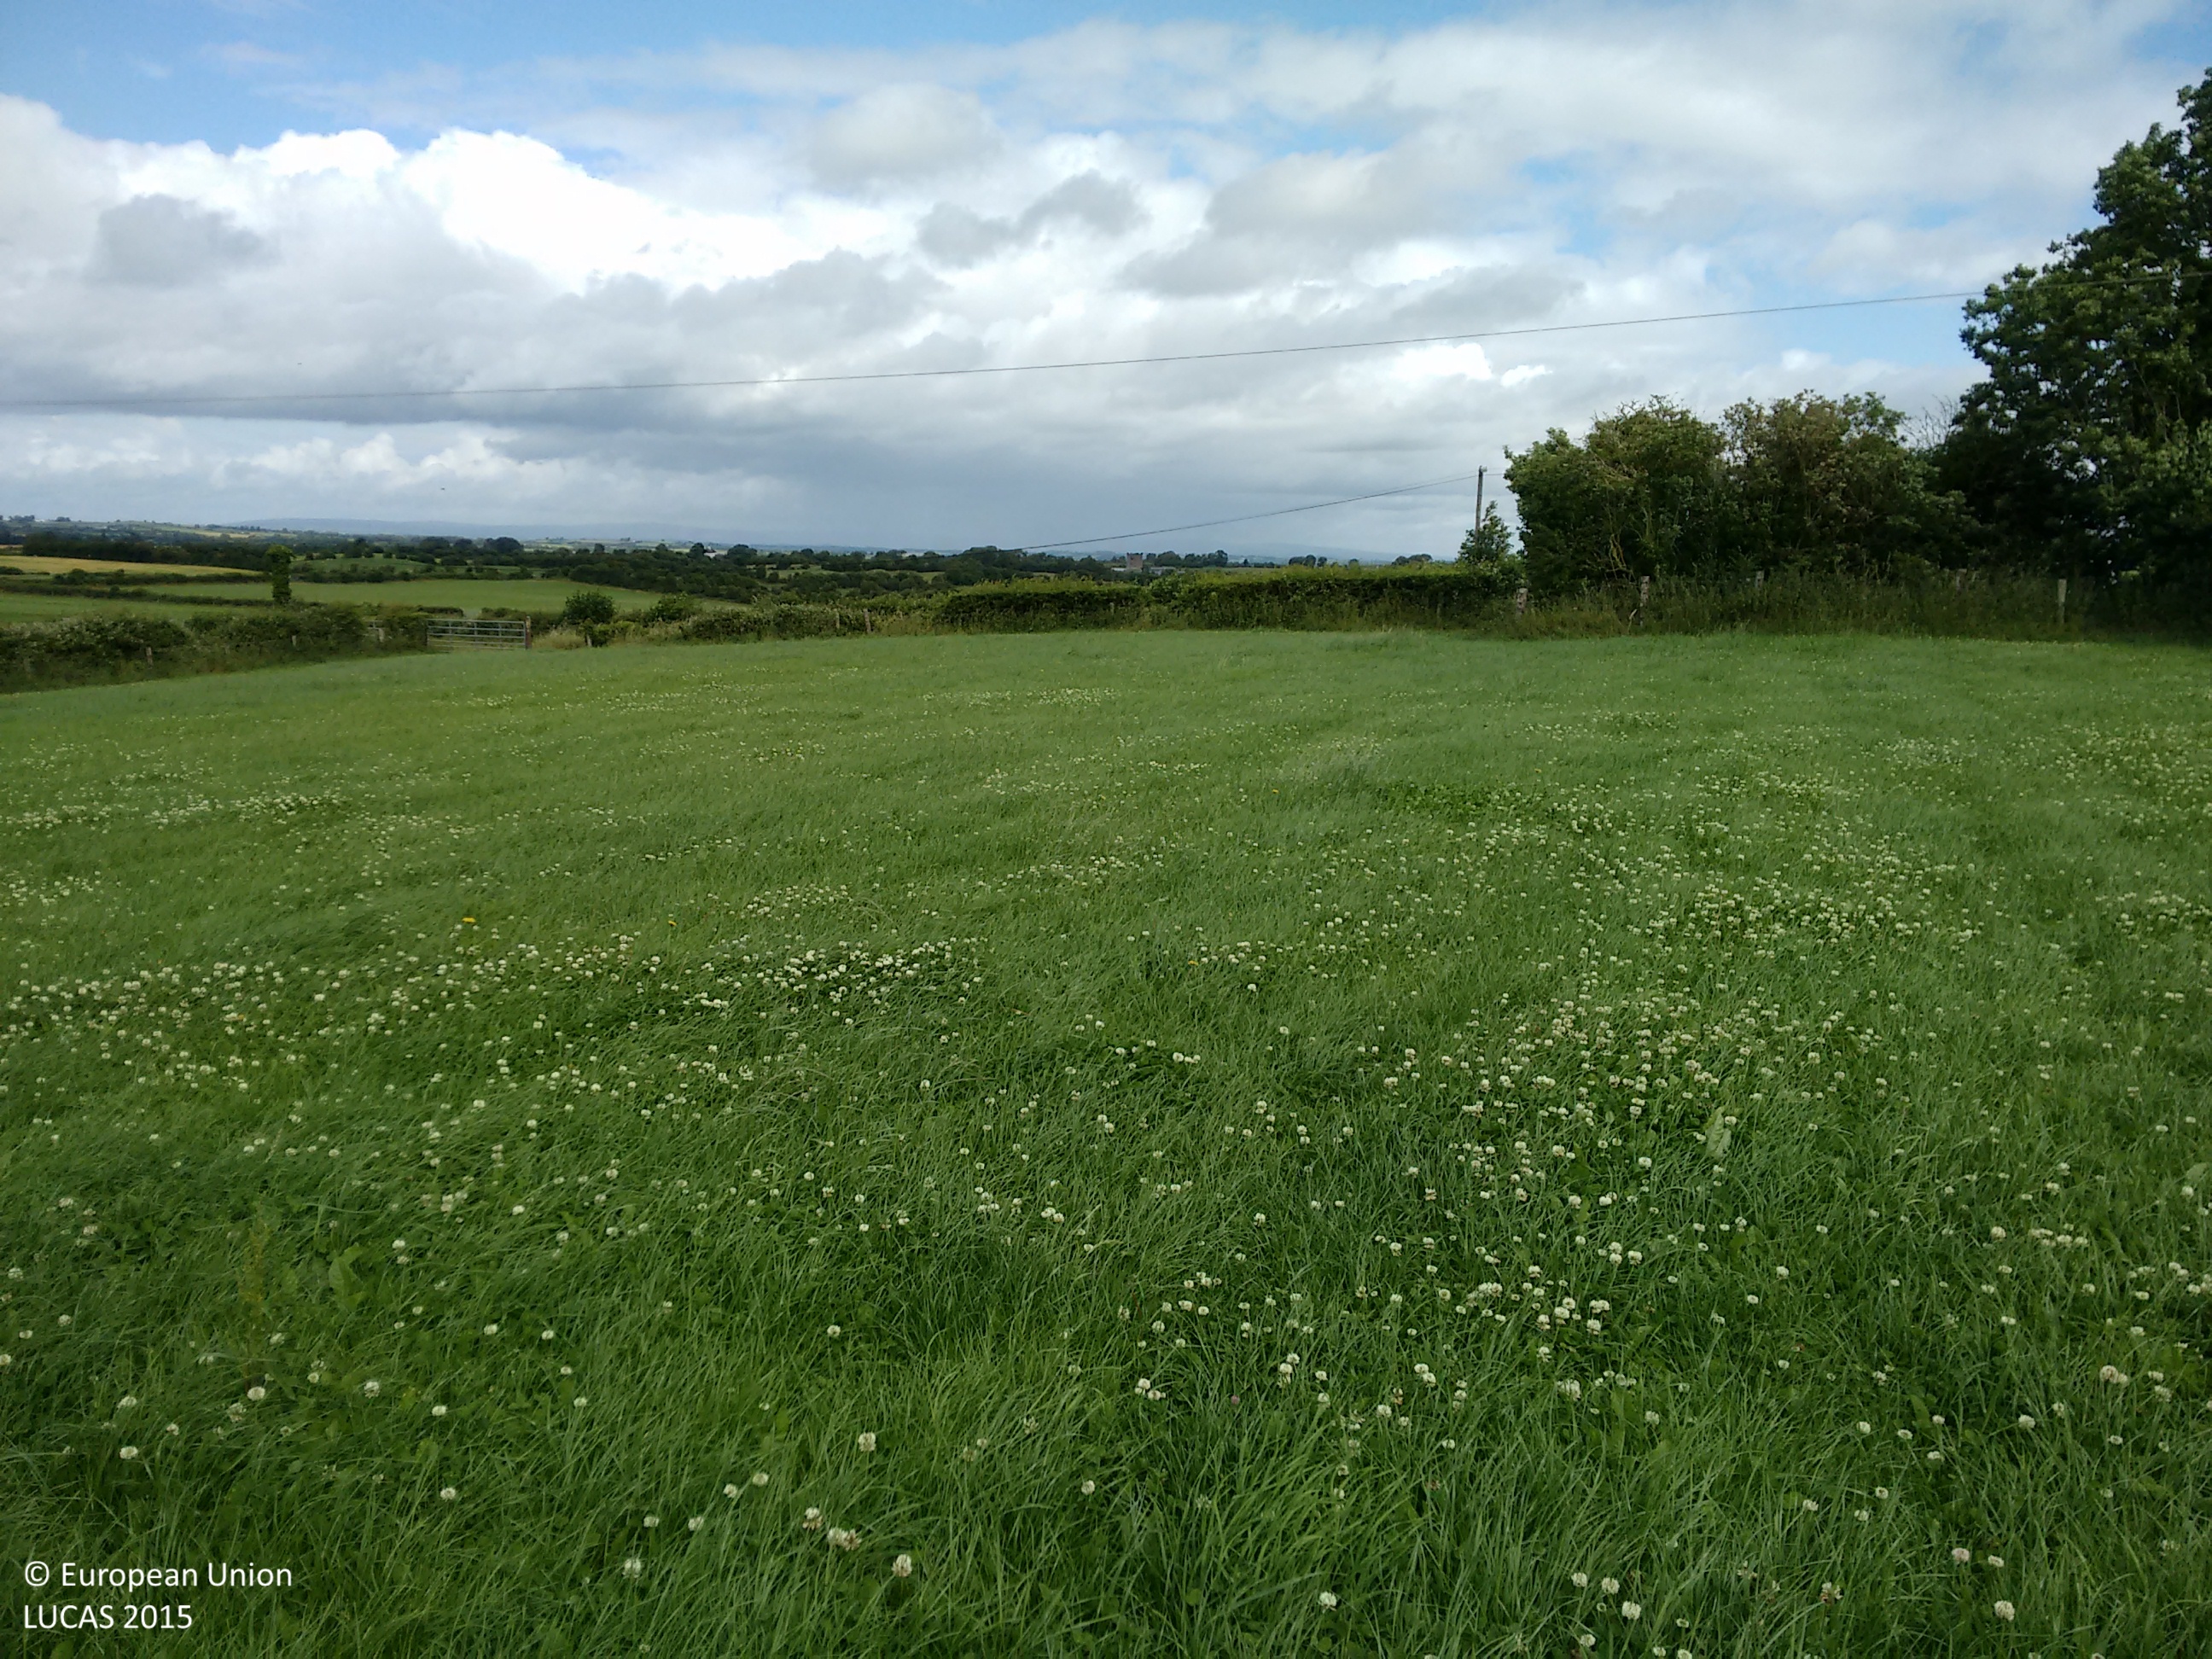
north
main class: Grassland
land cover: Grassland without tree/shrub cover
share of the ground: > 75 %
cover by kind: herbaceous plants 100 %
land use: Agriculture (excluding fallow land and kitchen gardens)
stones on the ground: < 10 %
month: July
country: IE
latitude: 52.7734
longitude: -7.5171
